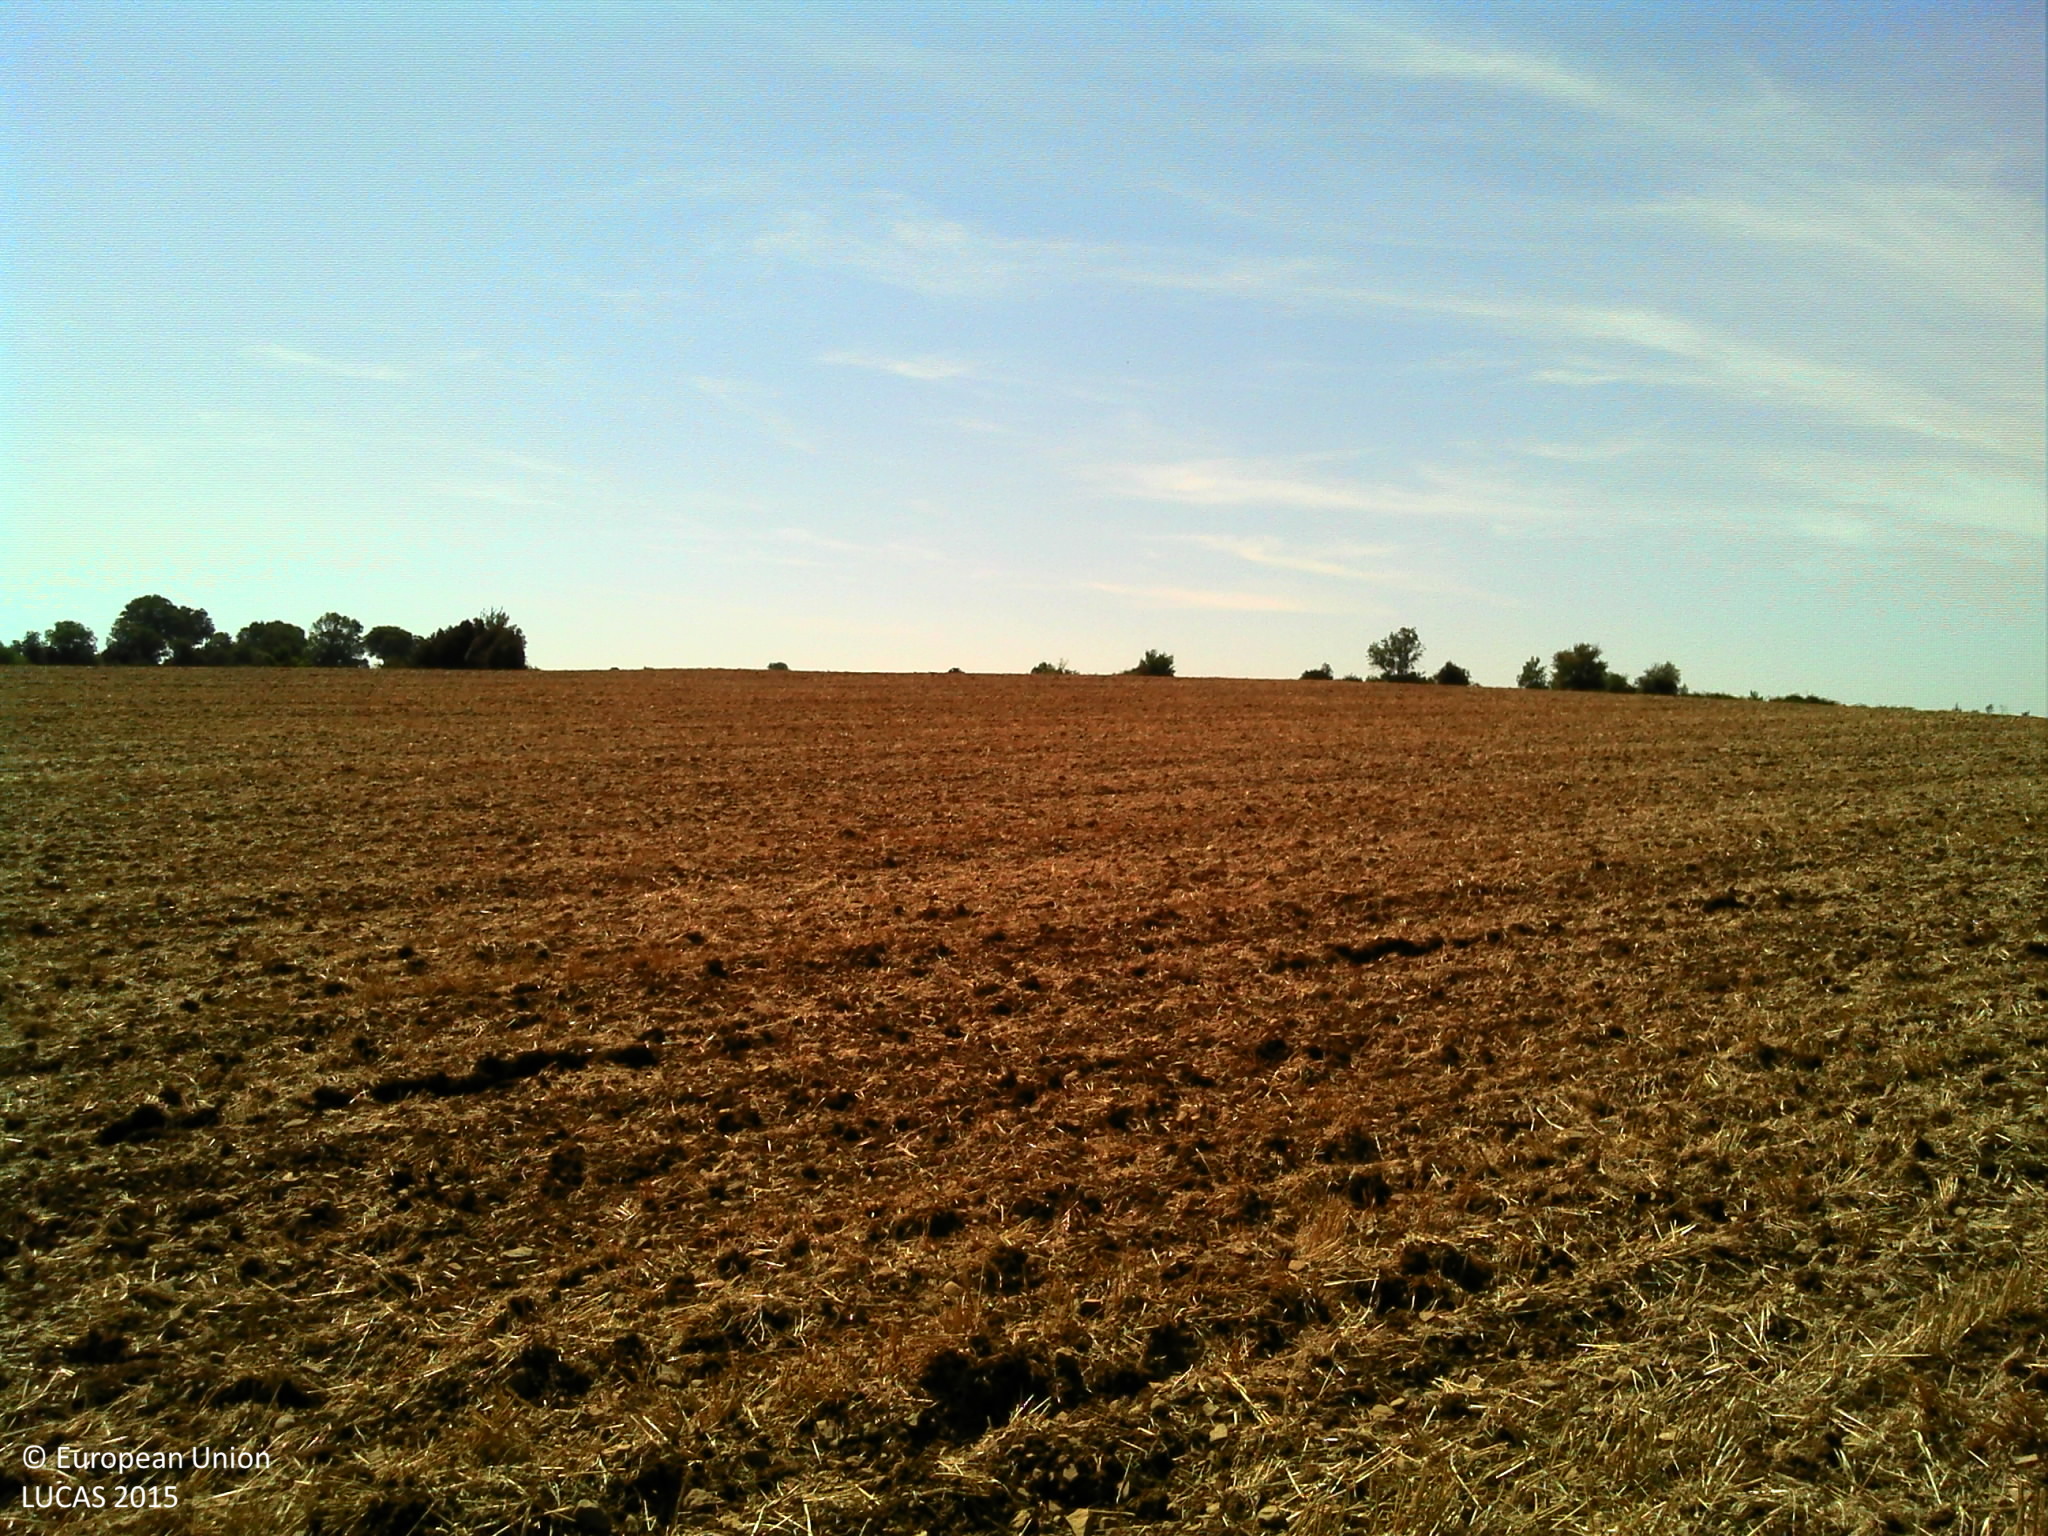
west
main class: Cropland
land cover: Barley
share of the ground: > 75 %
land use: Agriculture (excluding fallow land and kitchen gardens)
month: August
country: FR
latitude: 43.9342
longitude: 3.0180
